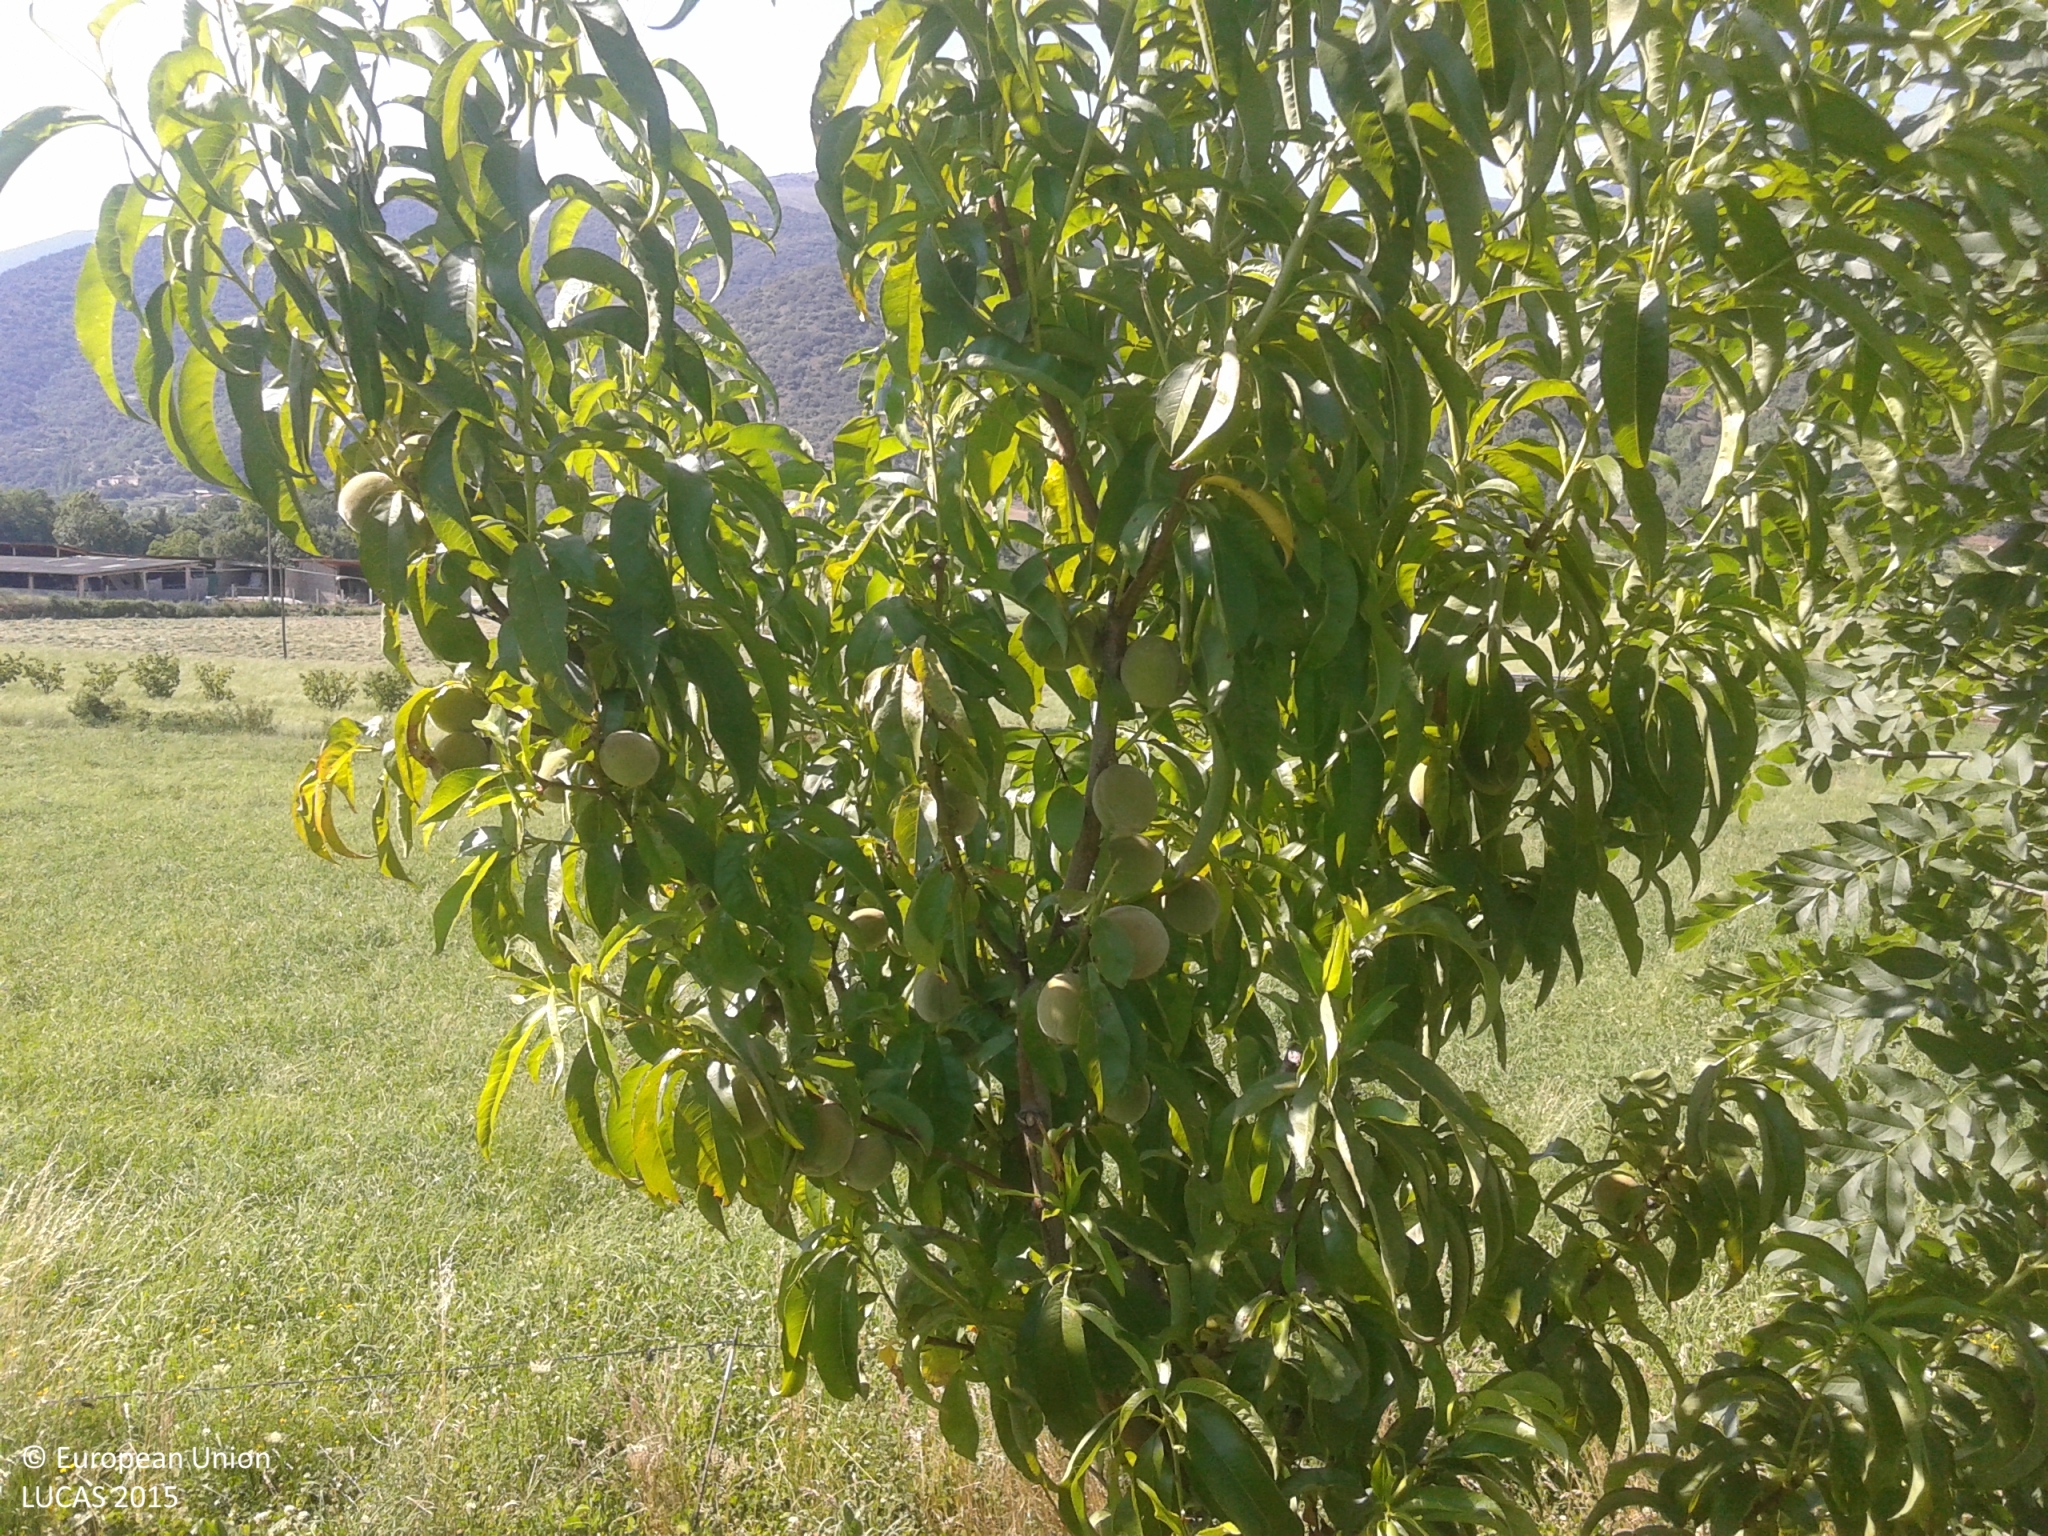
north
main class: Grassland
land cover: Grassland without tree/shrub cover
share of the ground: > 75 %
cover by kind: herbaceous plants 100 %
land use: Agriculture (excluding fallow land and kitchen gardens)
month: June
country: ES
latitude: 42.3507
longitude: 1.5003
